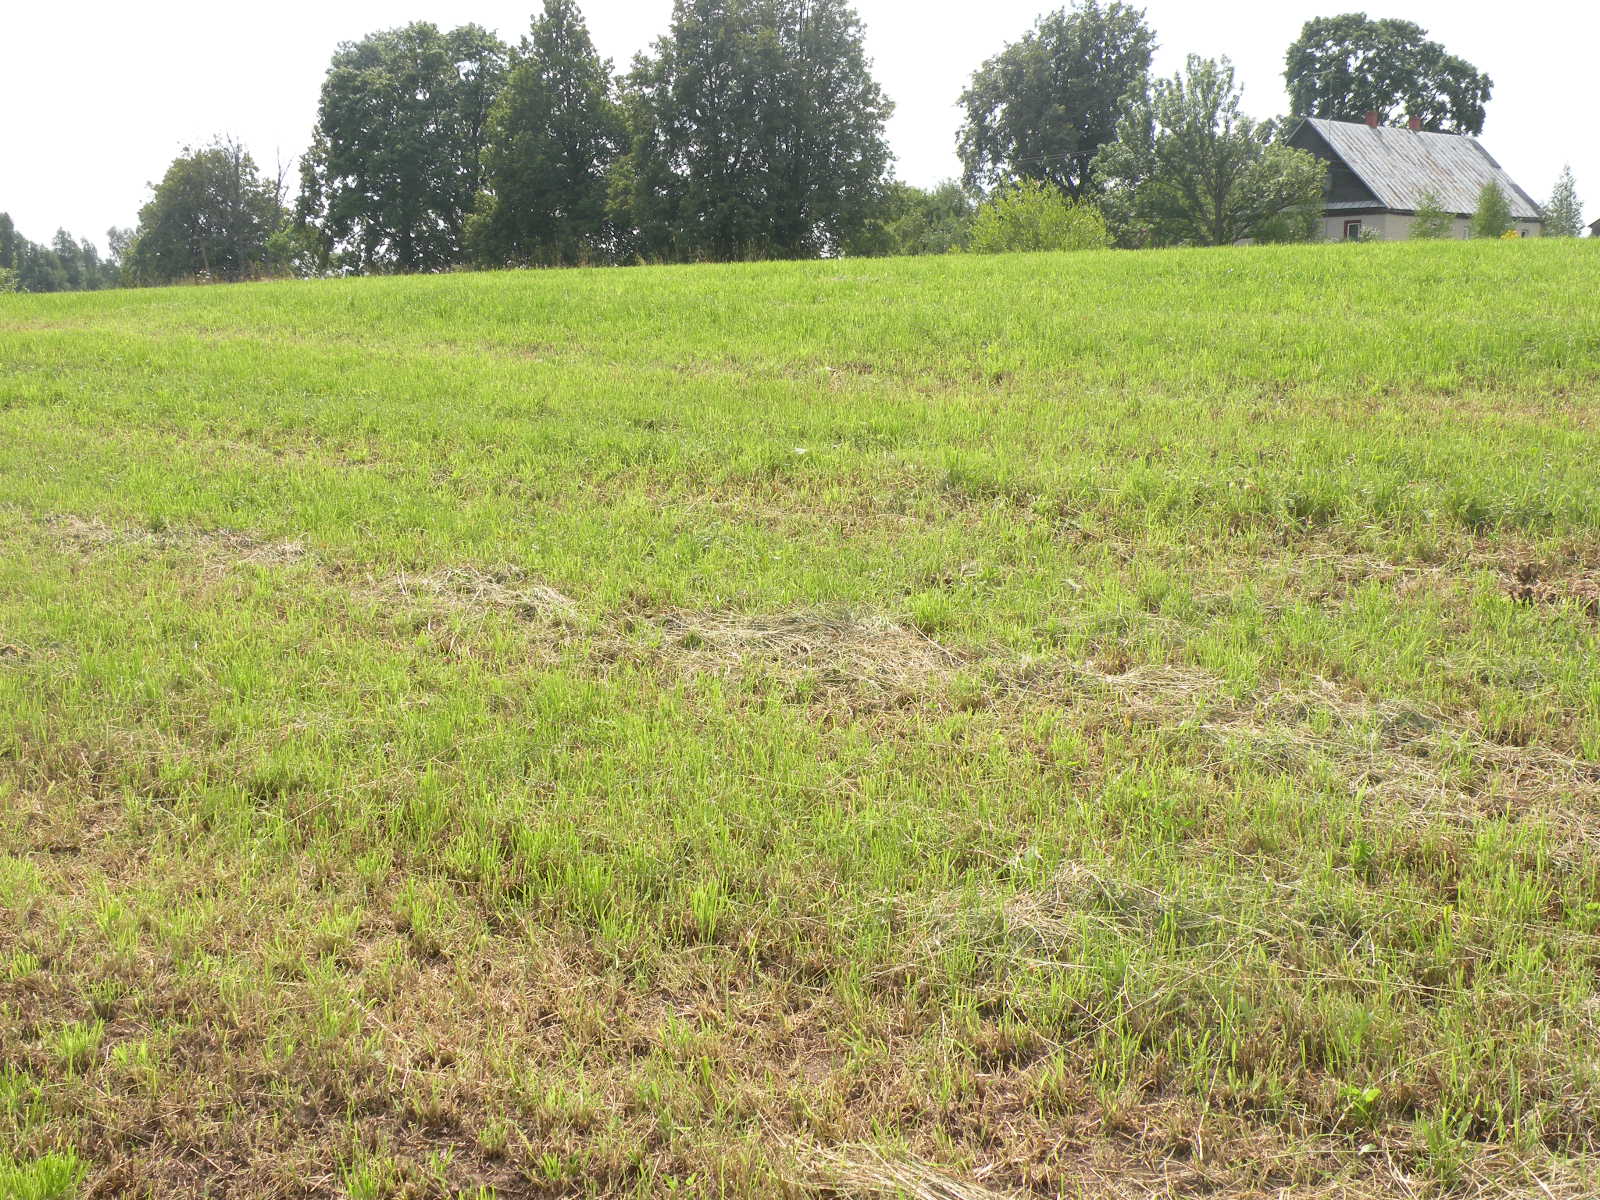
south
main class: Grassland
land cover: Grassland without tree/shrub cover
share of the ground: > 75 %
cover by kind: herbaceous plants 100 %
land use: Agriculture (excluding fallow land and kitchen gardens)
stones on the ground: < 10 %
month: July
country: LV
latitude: 55.8211
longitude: 26.6758
